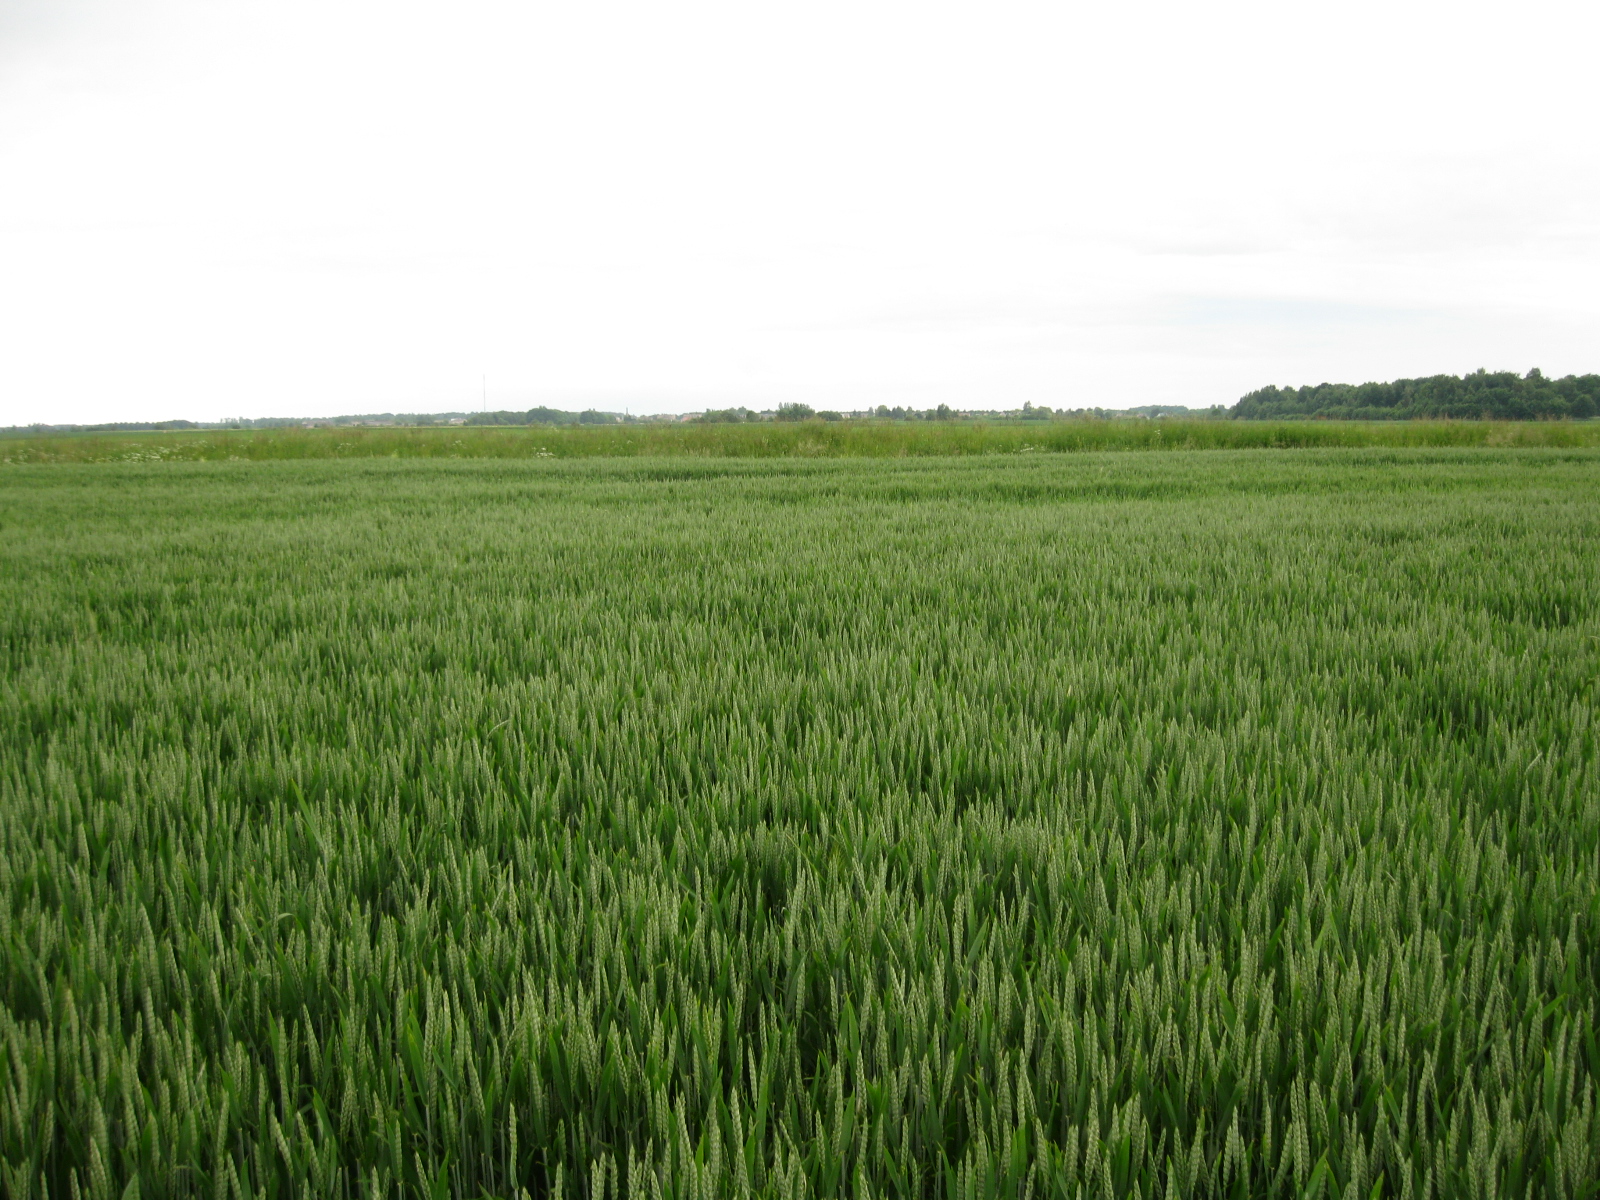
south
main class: Cropland
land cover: Common wheat
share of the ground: > 75 %
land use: Agriculture (excluding fallow land and kitchen gardens)
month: June
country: LT
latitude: 55.2035
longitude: 24.0921
